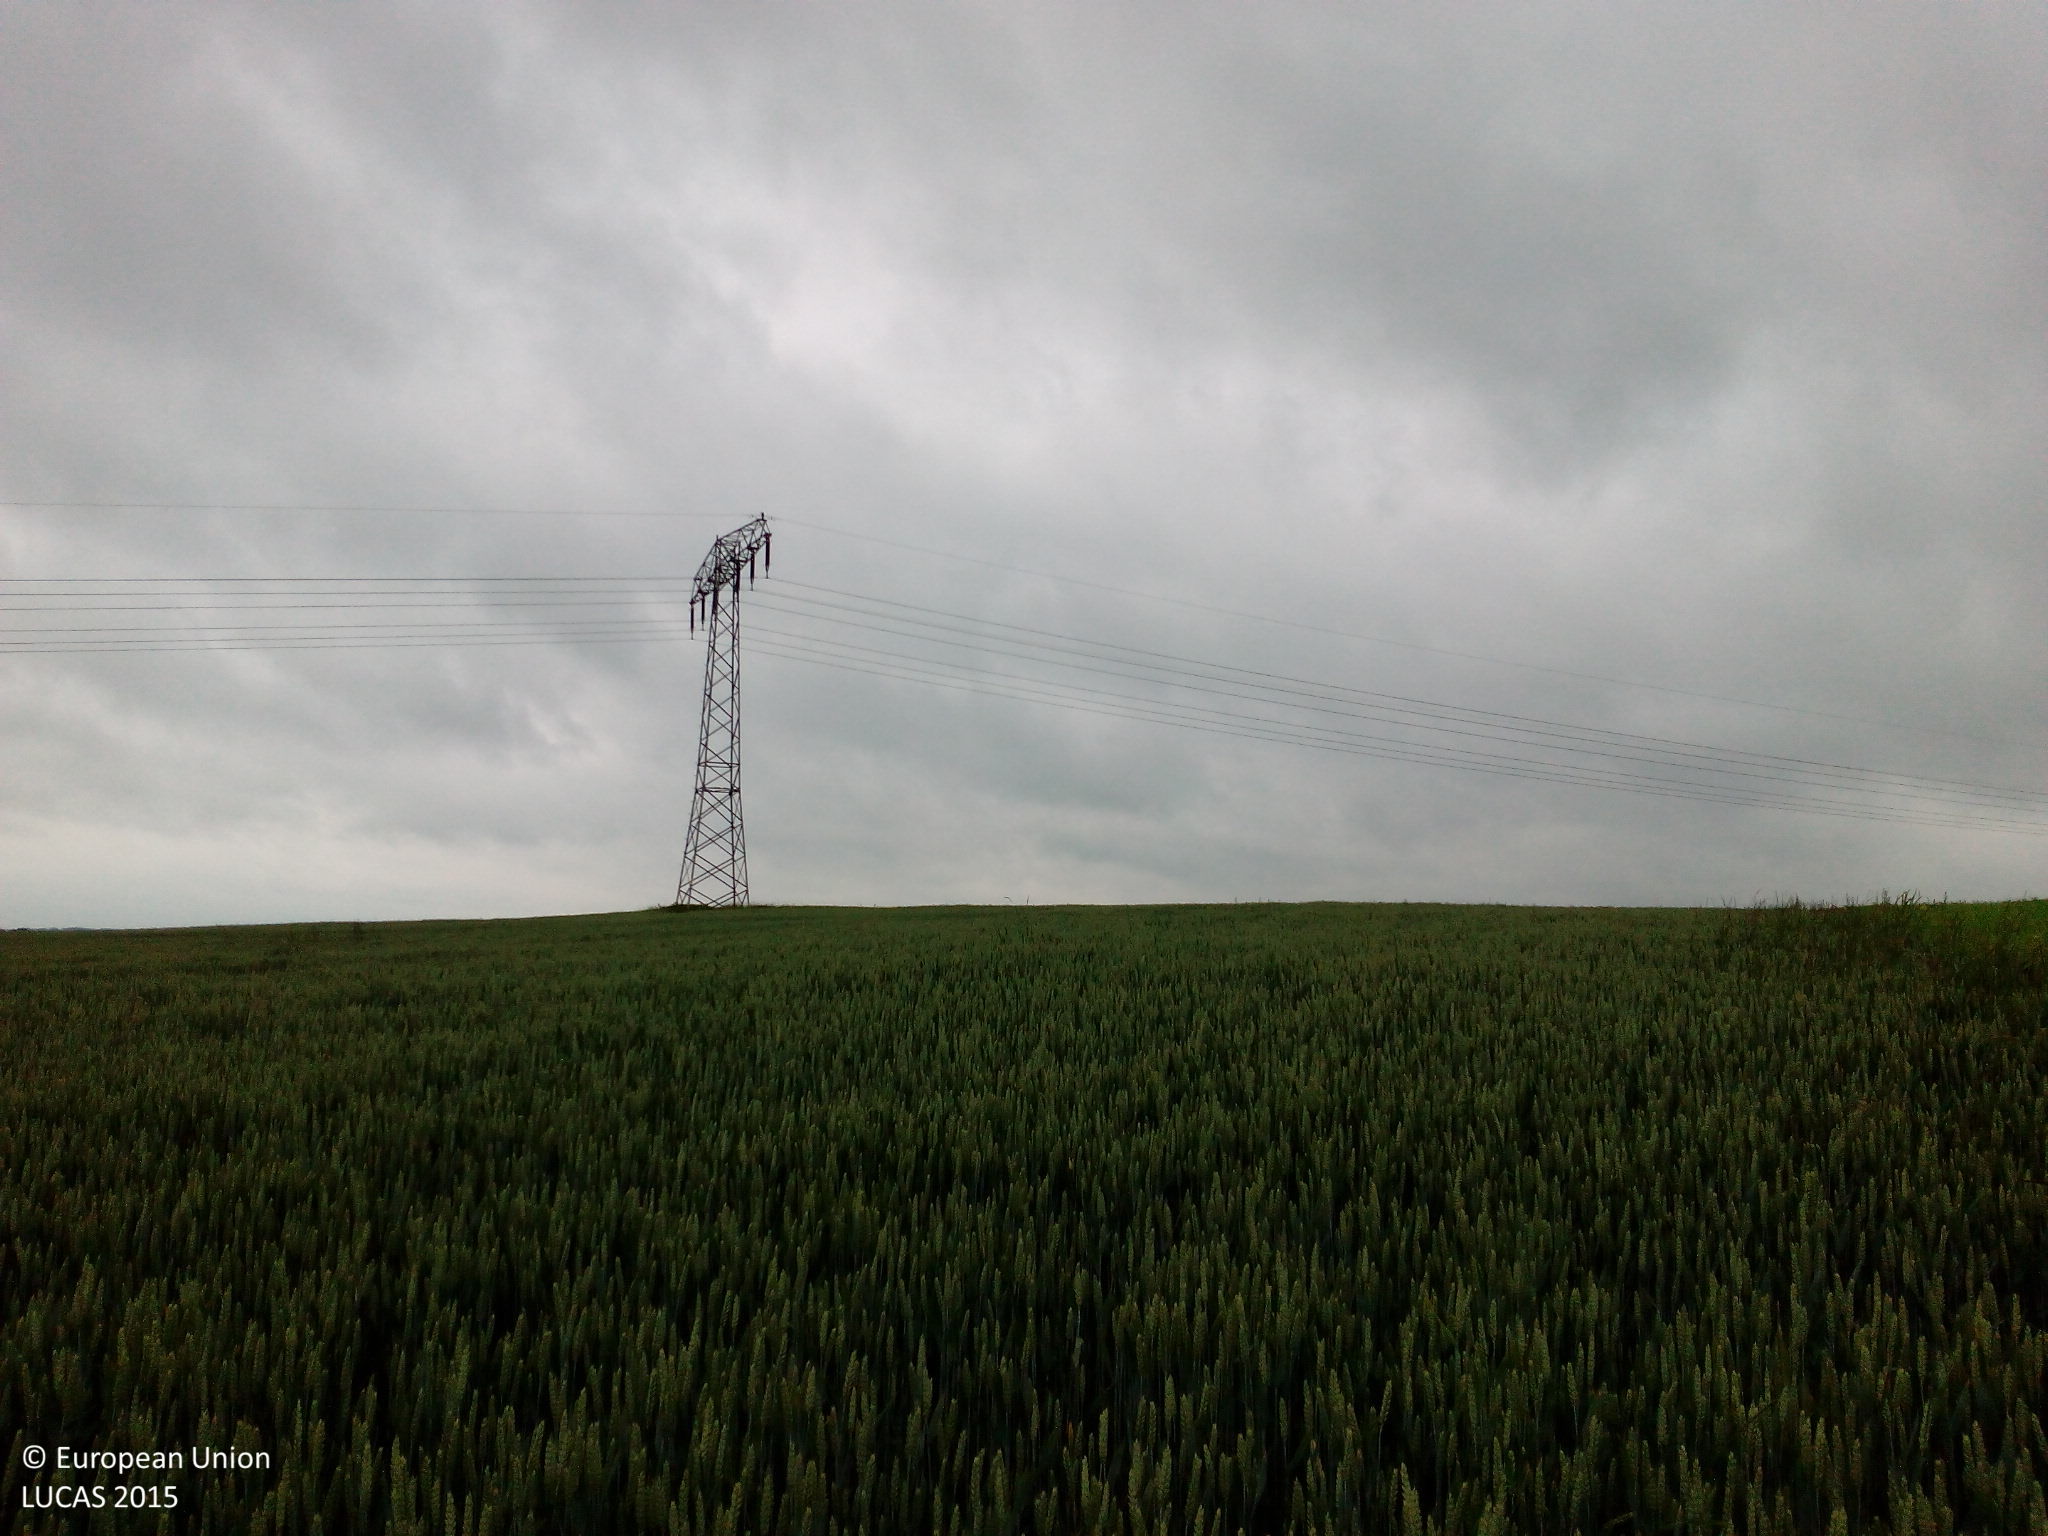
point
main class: Cropland
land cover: Common wheat
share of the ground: > 75 %
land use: Agriculture (excluding fallow land and kitchen gardens)
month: June
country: DE
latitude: 51.0958
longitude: 13.0987
